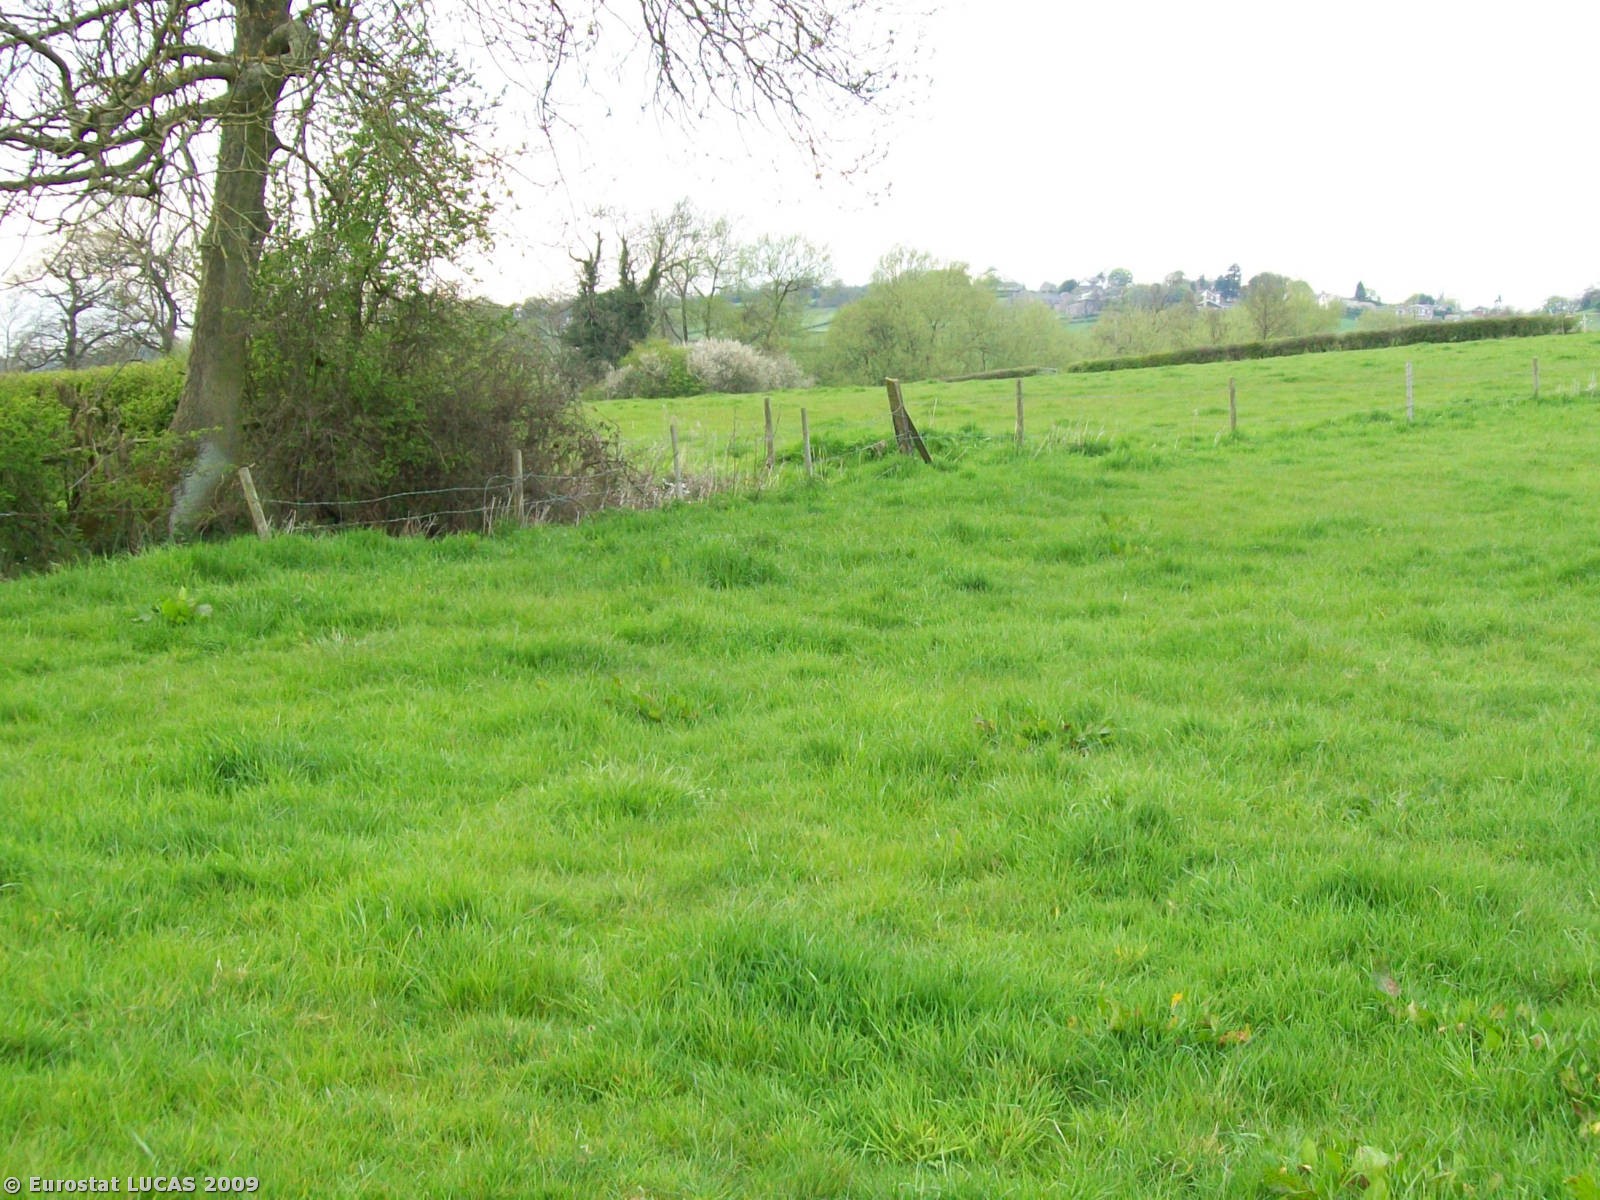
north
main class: Grassland
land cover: Grassland with sparse tree/shrub cover
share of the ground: > 75 %
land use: Agriculture (excluding fallow land and kitchen gardens)
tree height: > 5 m
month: April
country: GB
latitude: 52.9965
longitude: -1.5083
